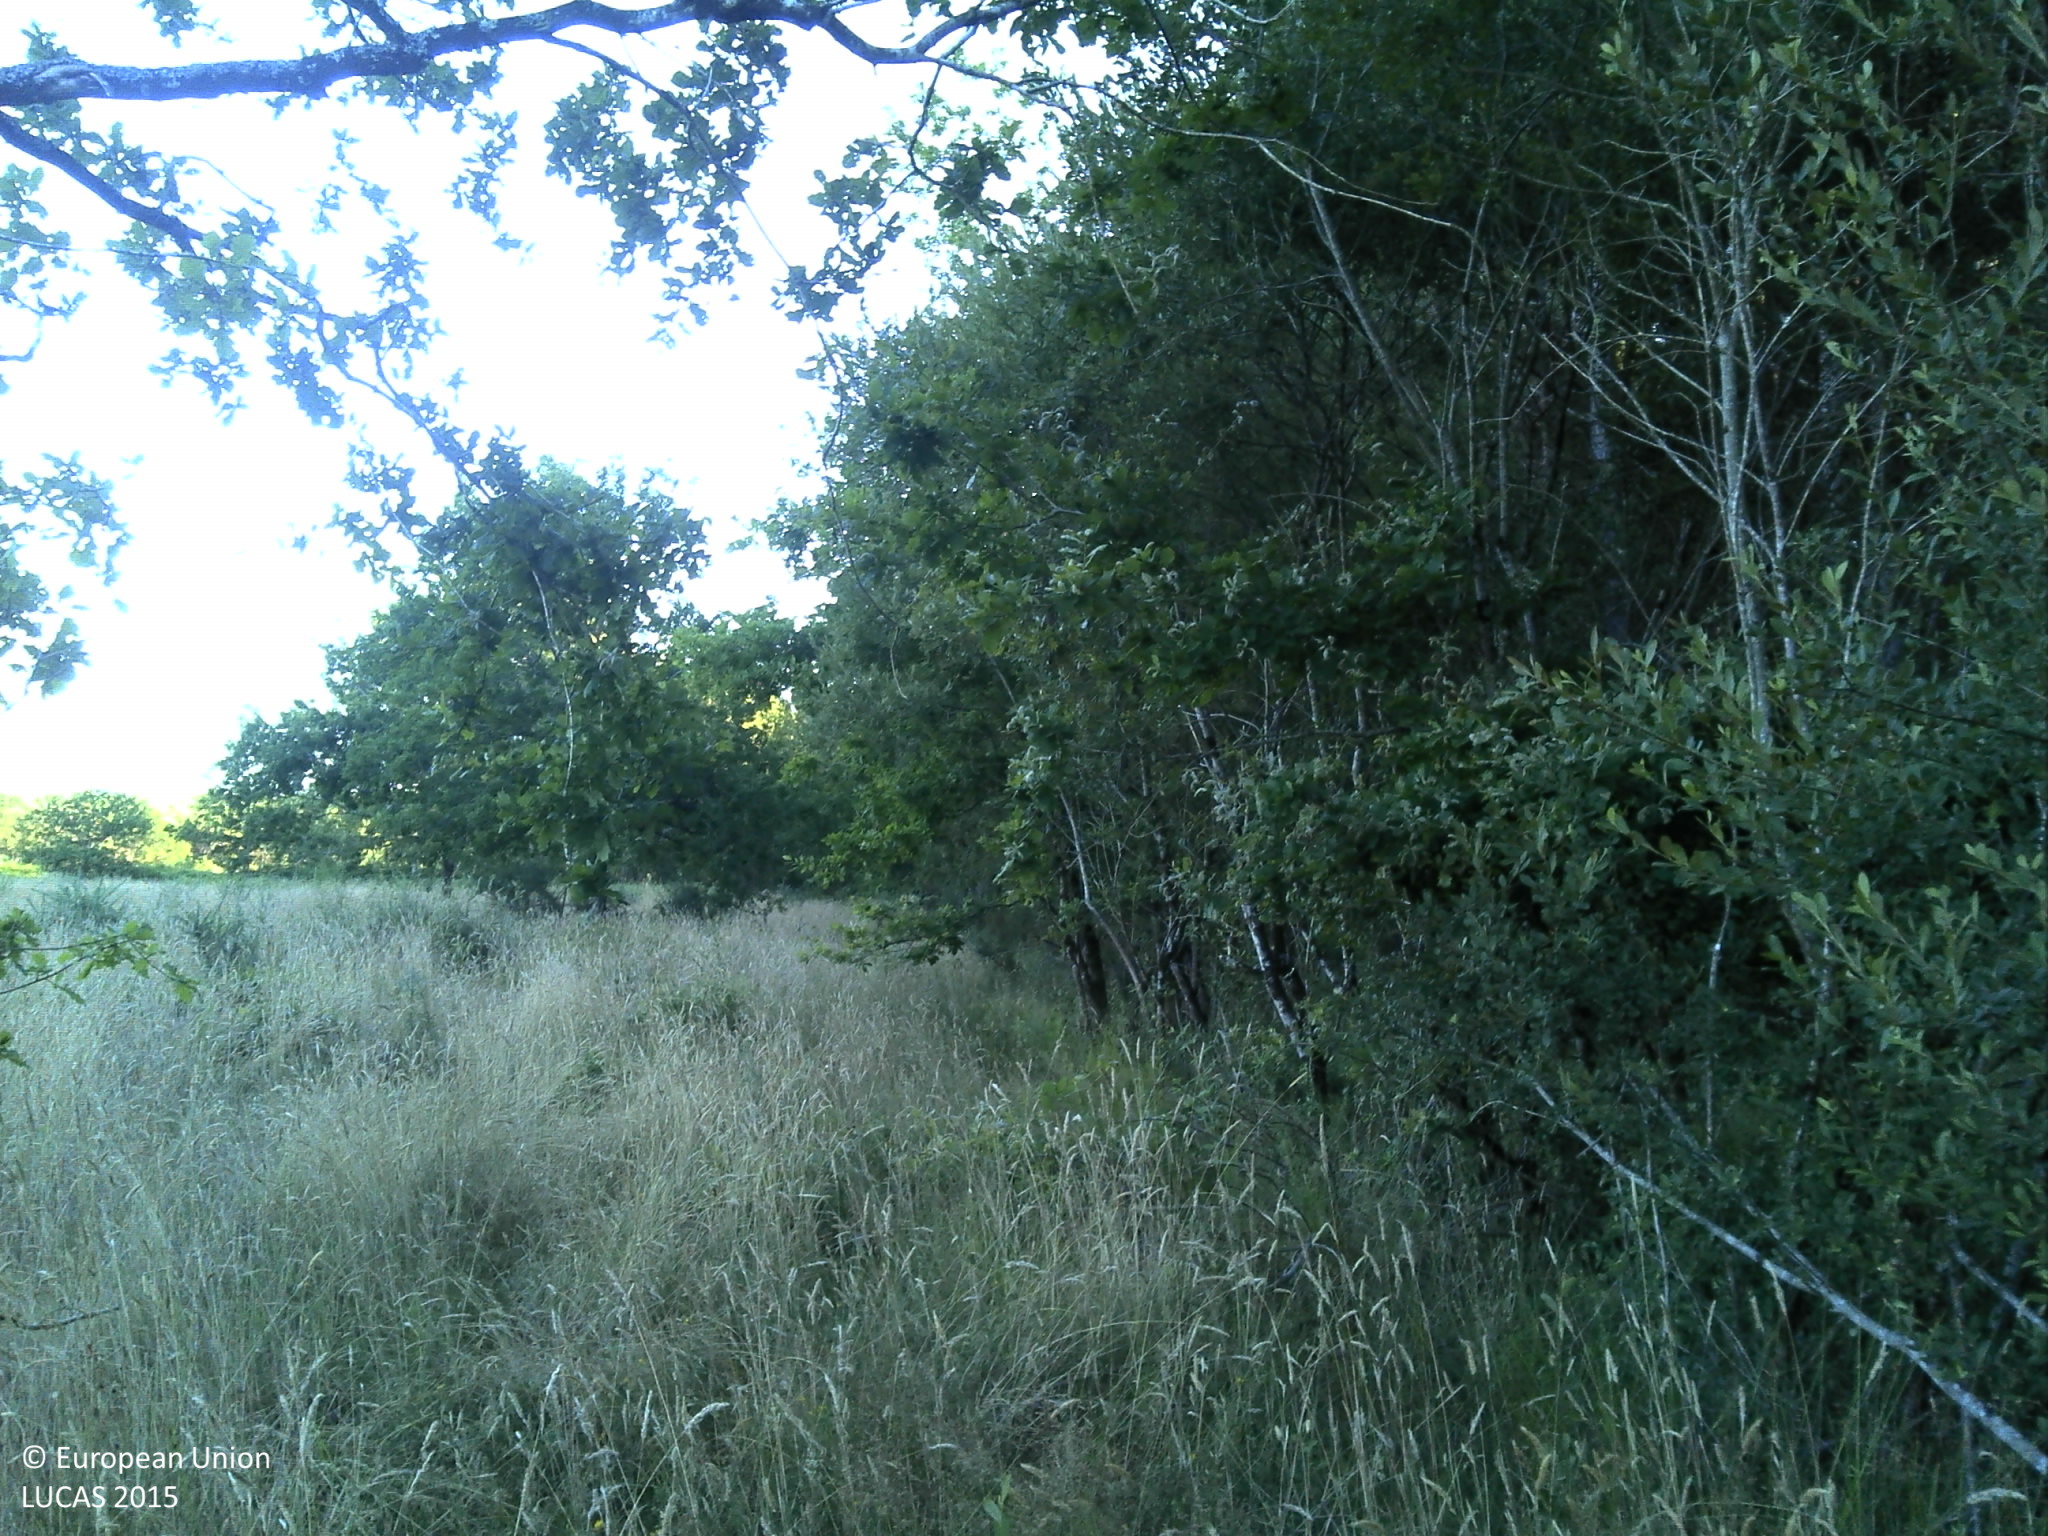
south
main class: Woodland
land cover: Pine dominated mixed woodland
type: exotic forest
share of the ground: > 75 %
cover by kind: coniferous forest trees 65 %, broadleaved forest trees 25 %, herbaceous plants 10 %
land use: Forestry
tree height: > 5 m
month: July
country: FR
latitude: 45.3391
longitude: -1.0650
